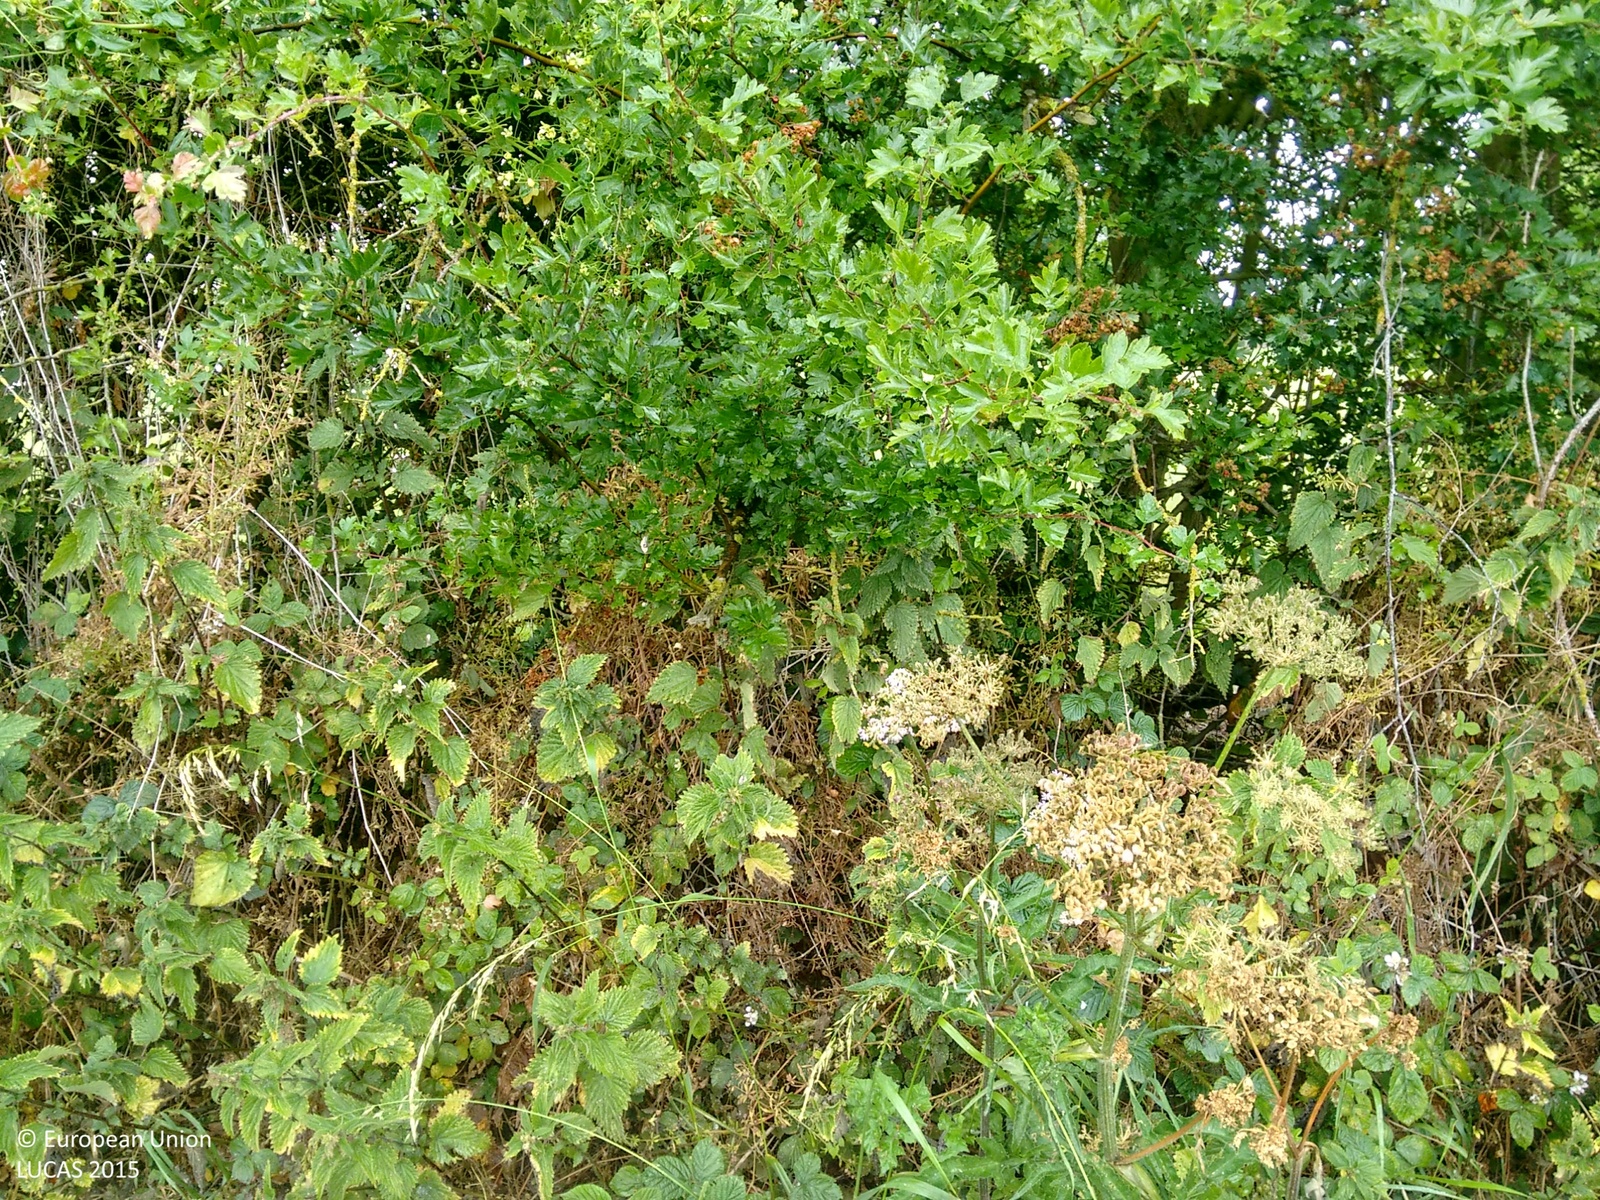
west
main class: Grassland
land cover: Grassland without tree/shrub cover
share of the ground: > 75 %
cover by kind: herbaceous plants 100 %
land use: Agriculture (excluding fallow land and kitchen gardens)
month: July
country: GB
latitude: 52.2456
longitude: -2.7991
